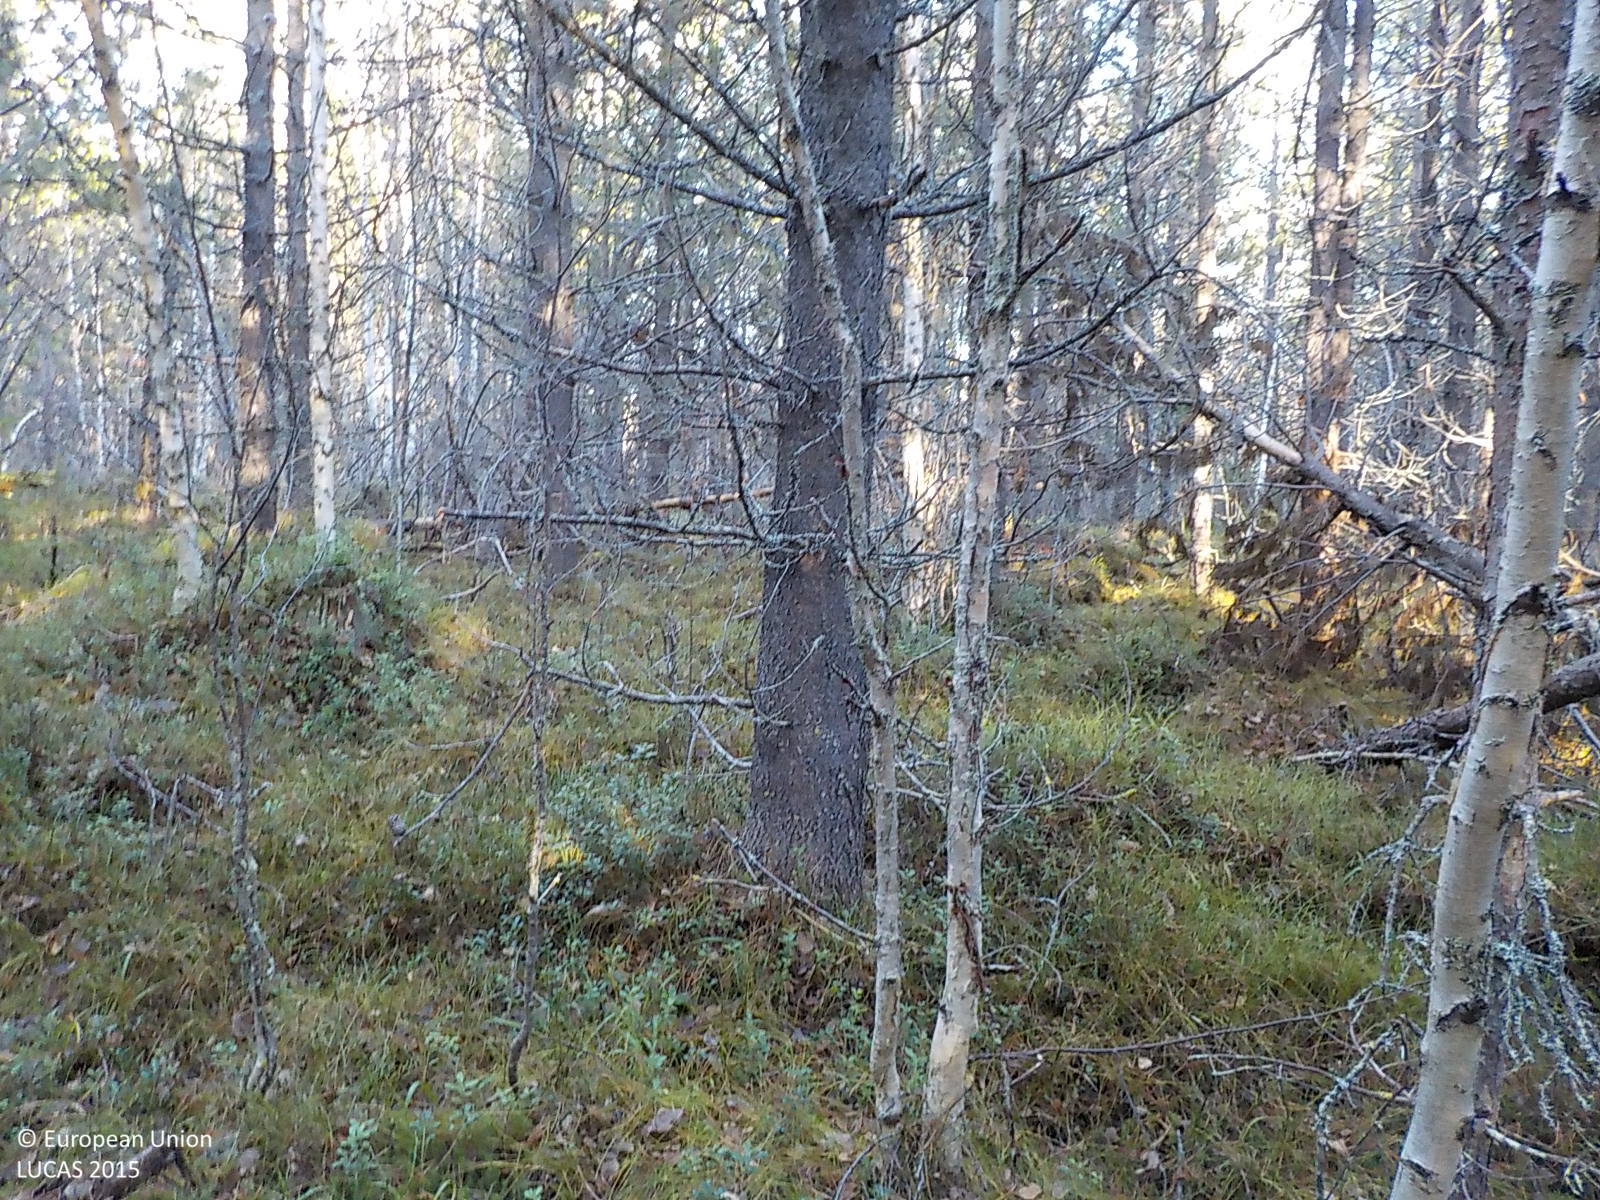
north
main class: Woodland
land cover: Pine dominated coniferous woodland
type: exotic forest
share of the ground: > 75 %
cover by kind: coniferous forest trees 80 %, shrubs 20 %
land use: Forestry
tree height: > 5 m
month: November
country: SE
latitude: 63.2330
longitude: 16.4834
